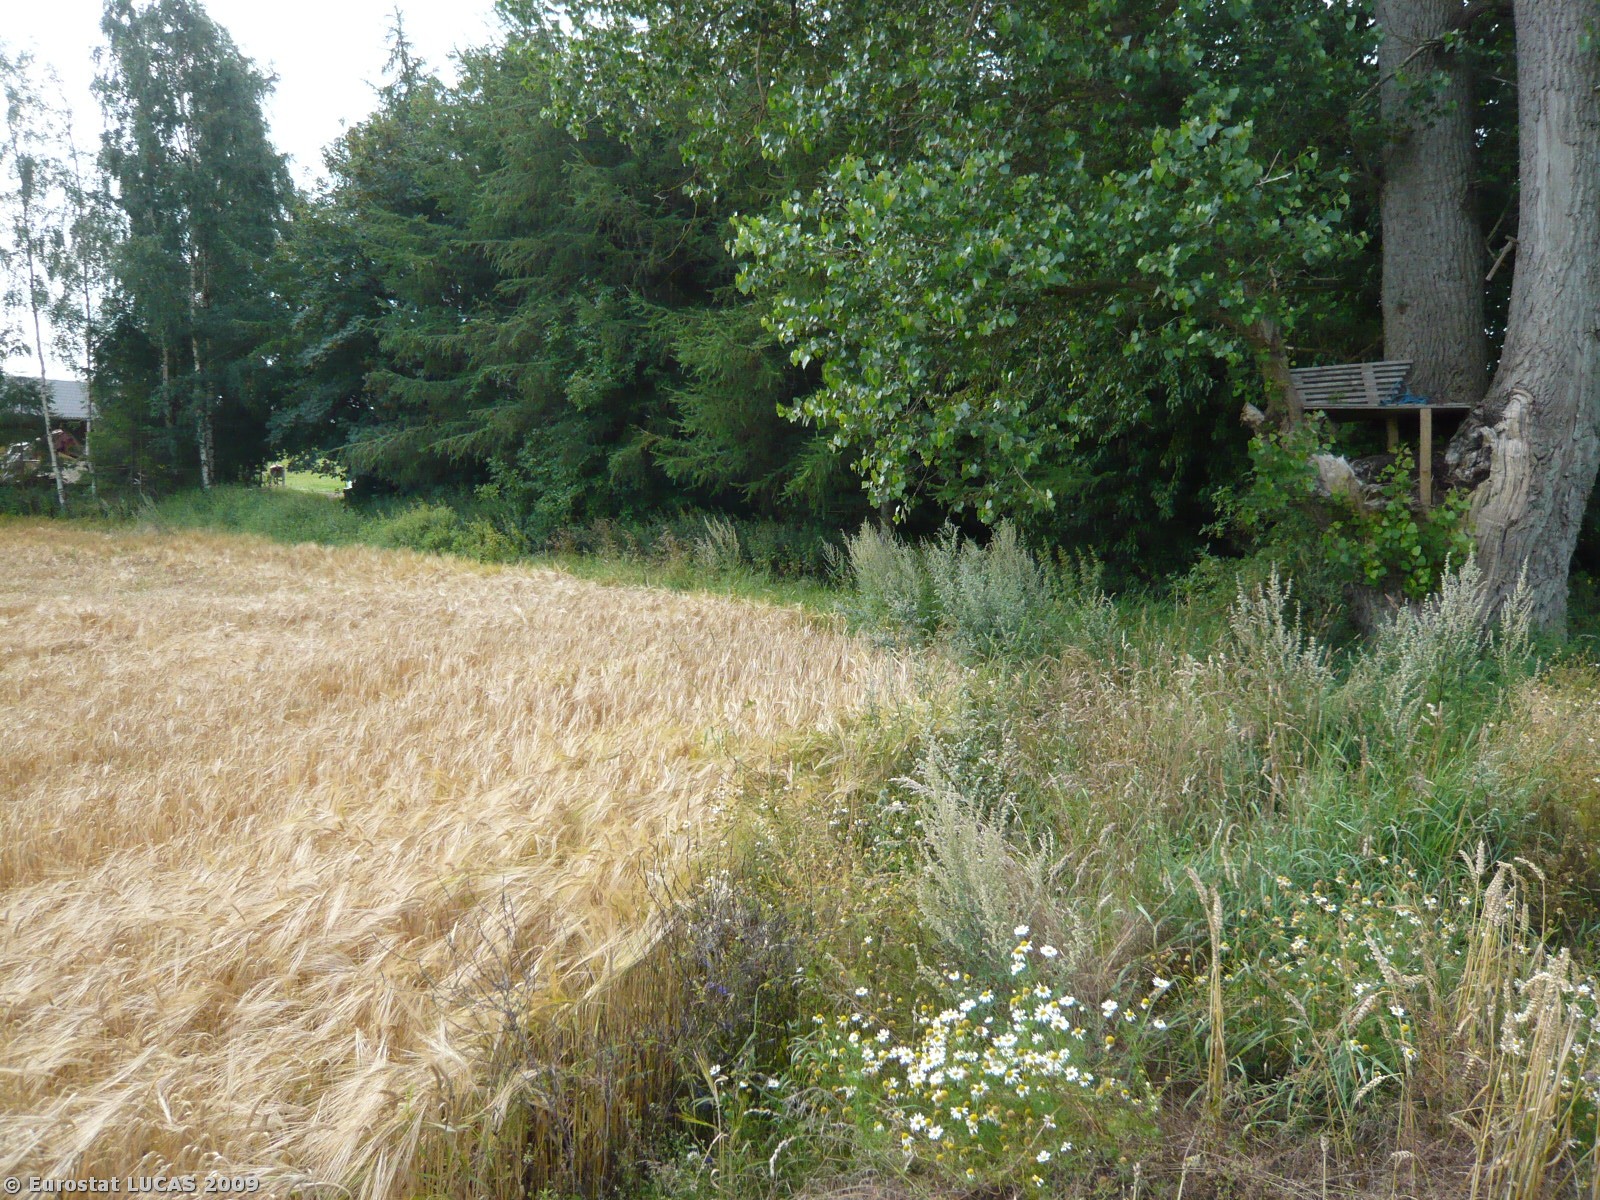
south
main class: Cropland
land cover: Barley
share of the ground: > 75 %
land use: Agriculture (excluding fallow land and kitchen gardens)
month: August
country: DK
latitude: 56.0257
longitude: 12.1640
